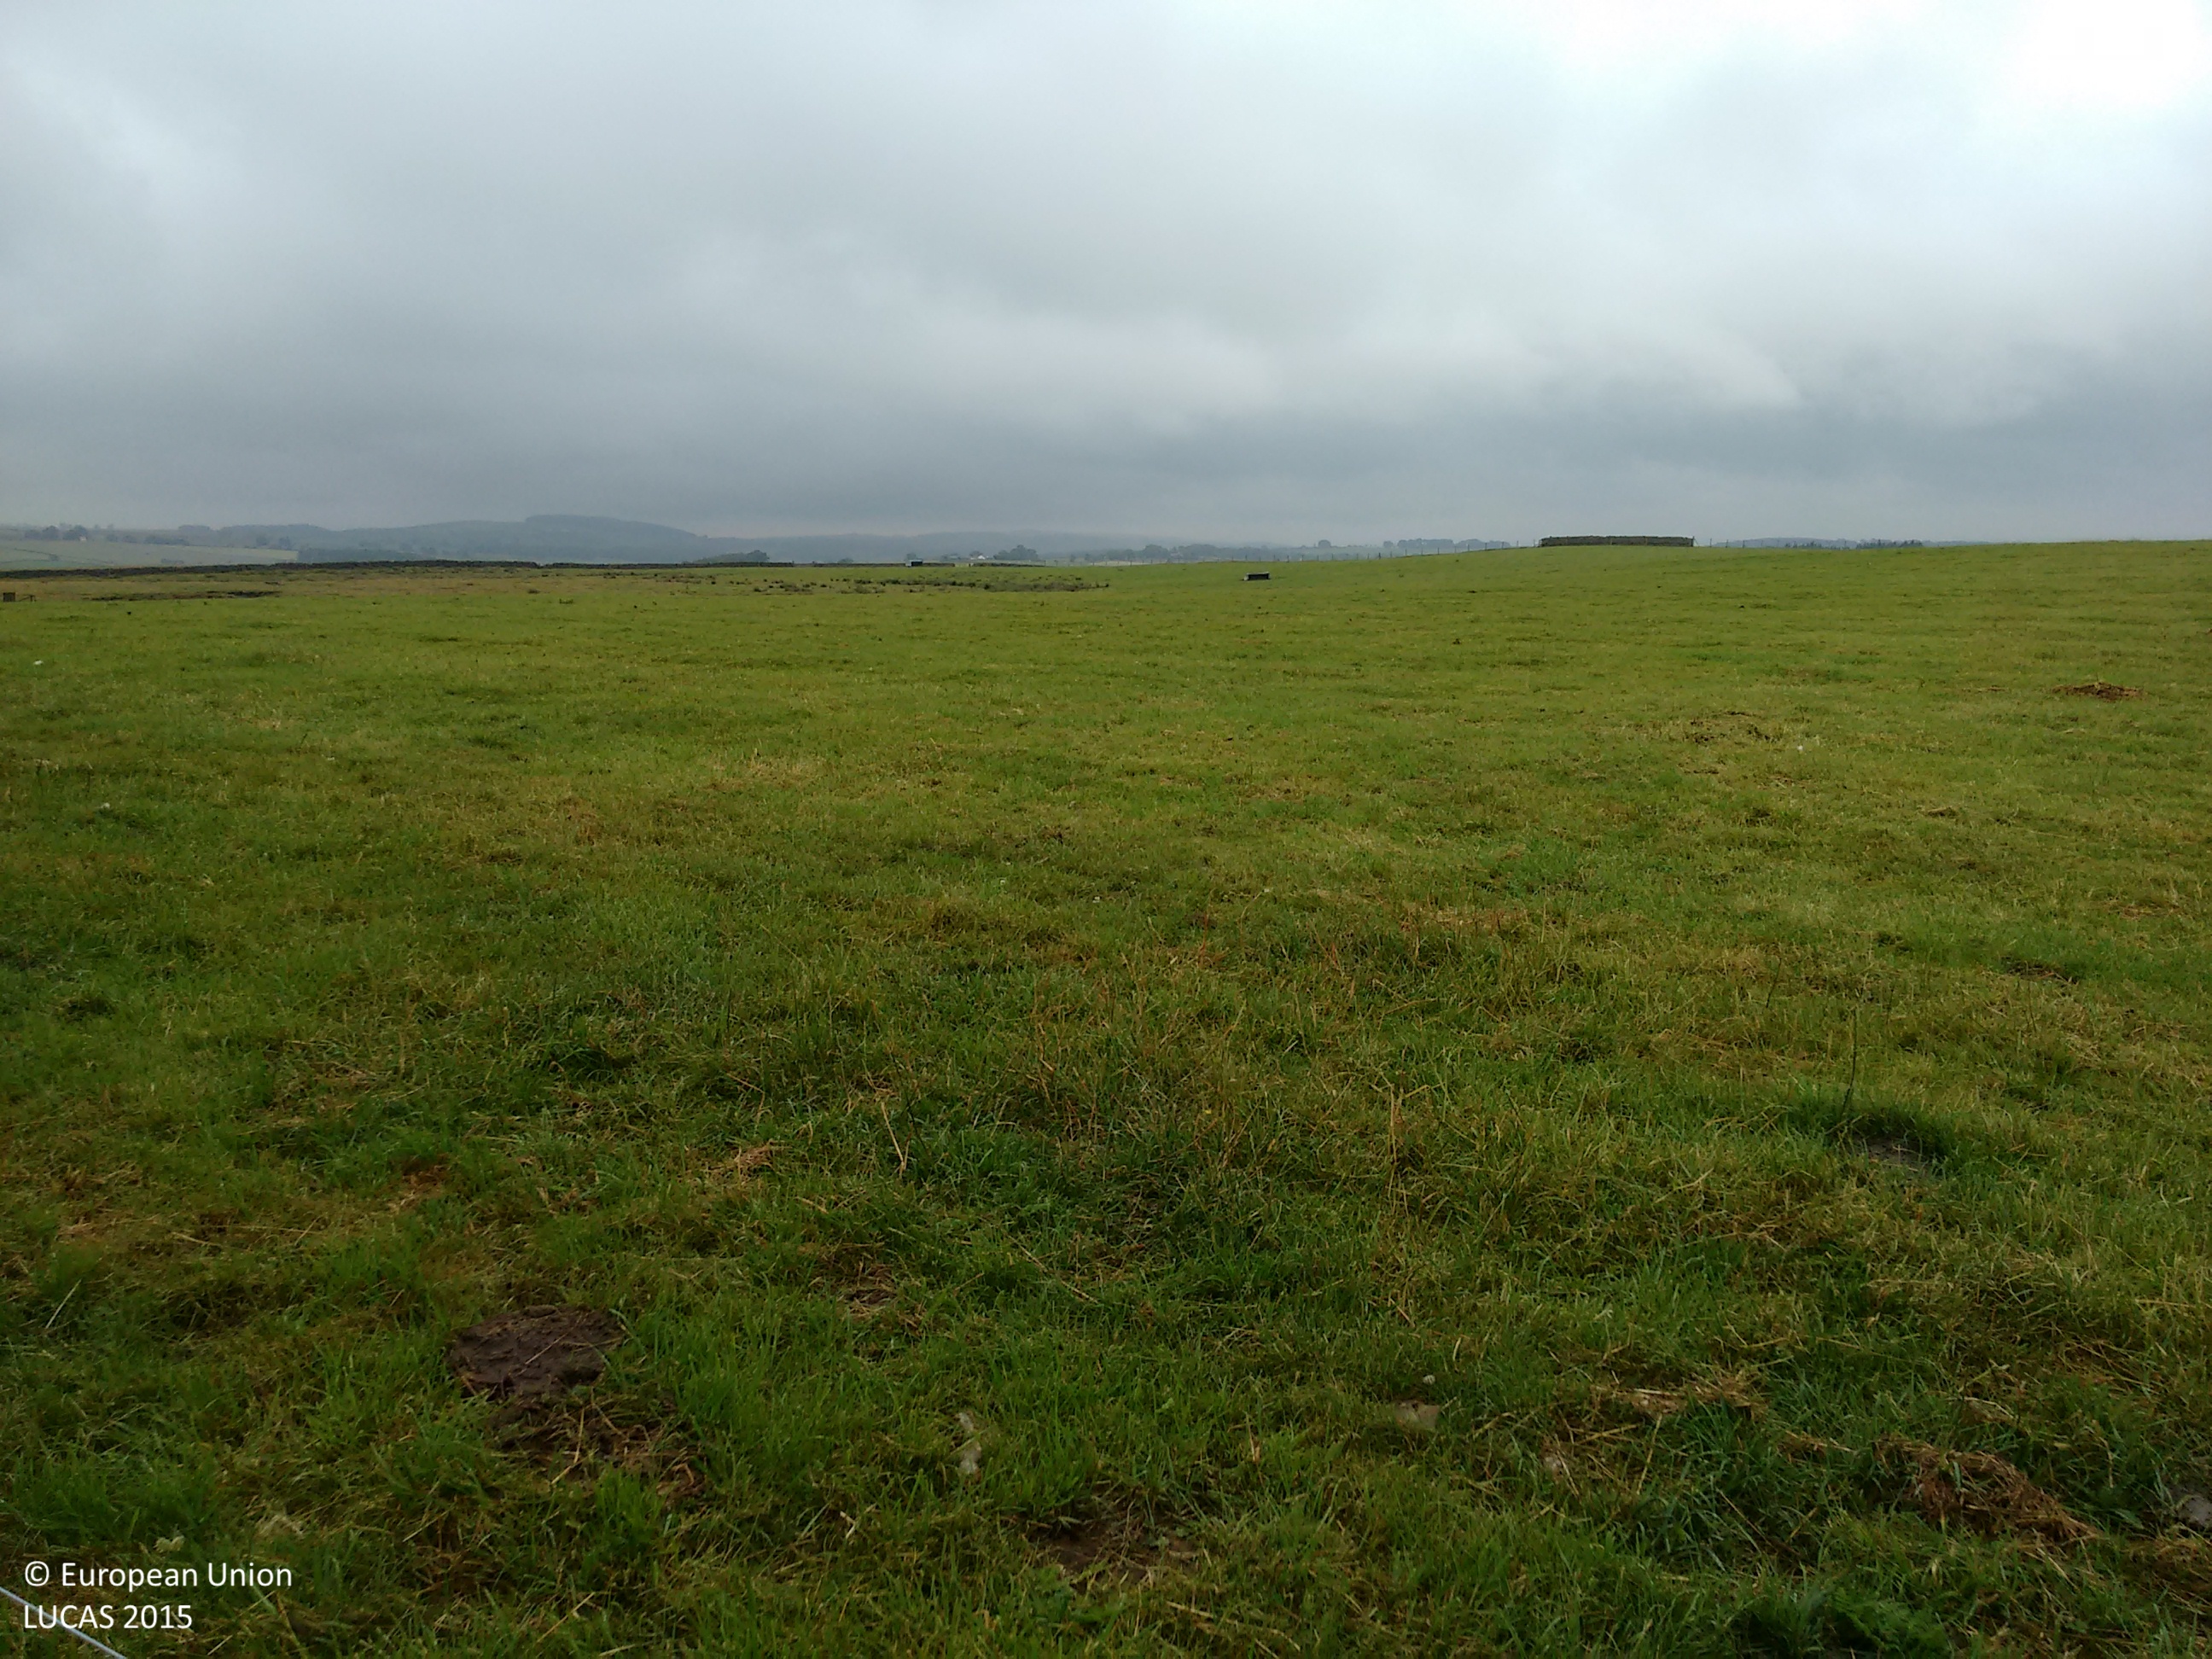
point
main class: Grassland
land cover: Grassland without tree/shrub cover
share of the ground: > 75 %
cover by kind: herbaceous plants 100 %
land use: Agriculture (excluding fallow land and kitchen gardens)
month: July
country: GB
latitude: 54.5894
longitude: -1.9553
